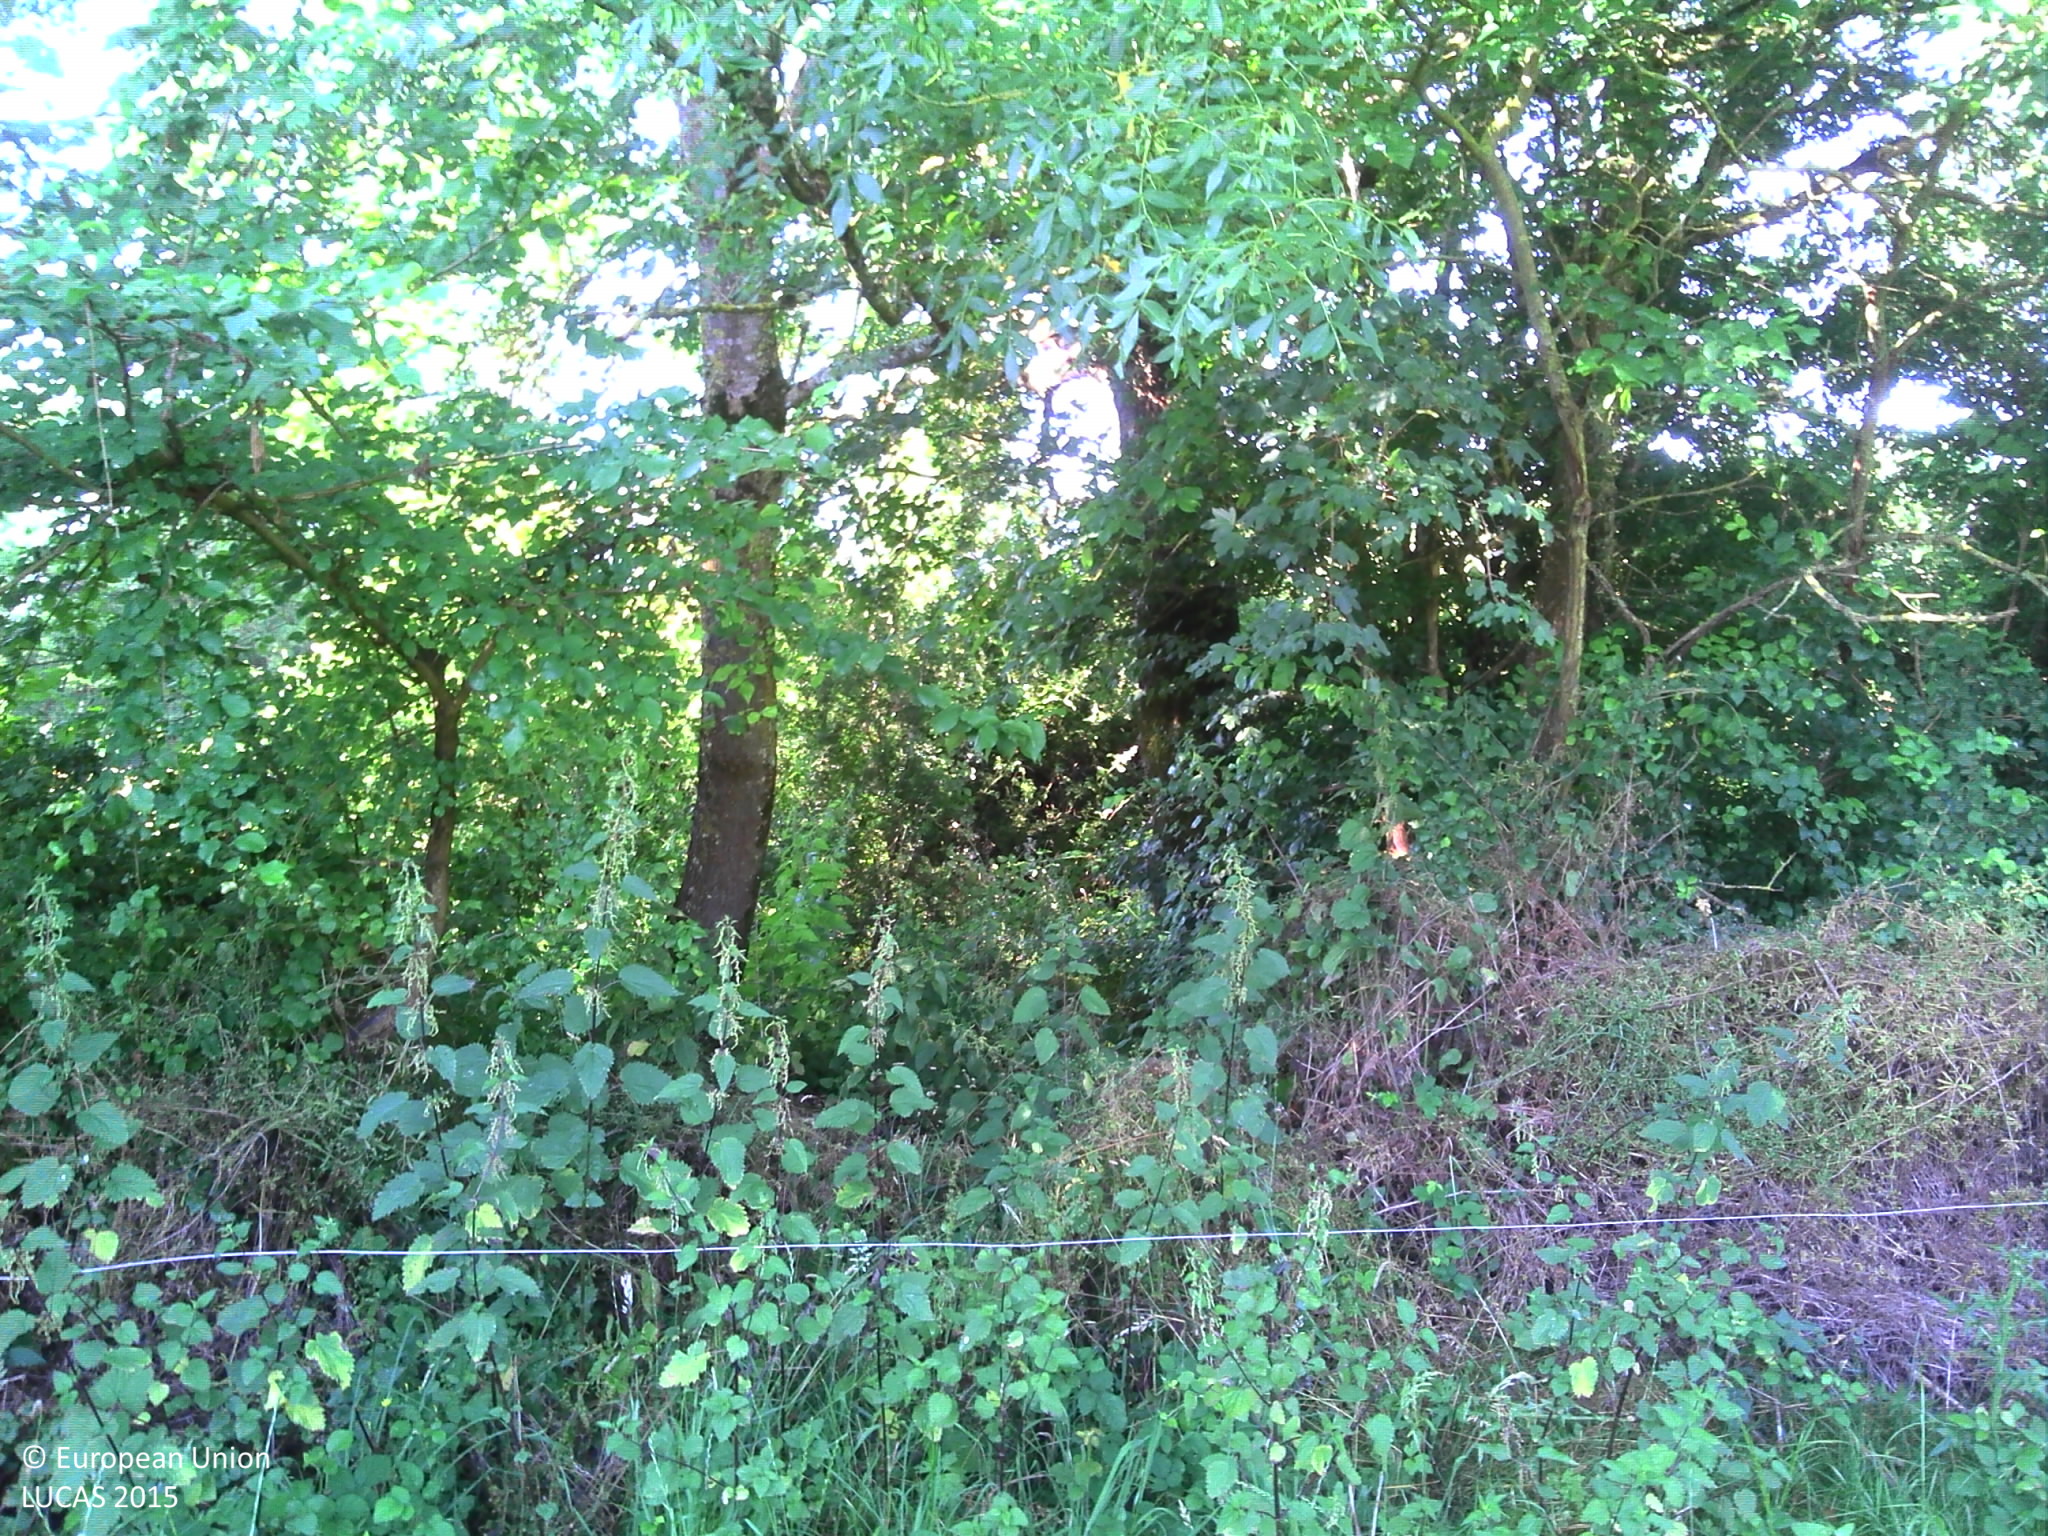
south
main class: Grassland
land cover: Grassland without tree/shrub cover
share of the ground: > 75 %
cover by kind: herbaceous plants 100 %
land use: Agriculture (excluding fallow land and kitchen gardens)
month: June
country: FR
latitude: 46.9710
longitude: -1.7815
